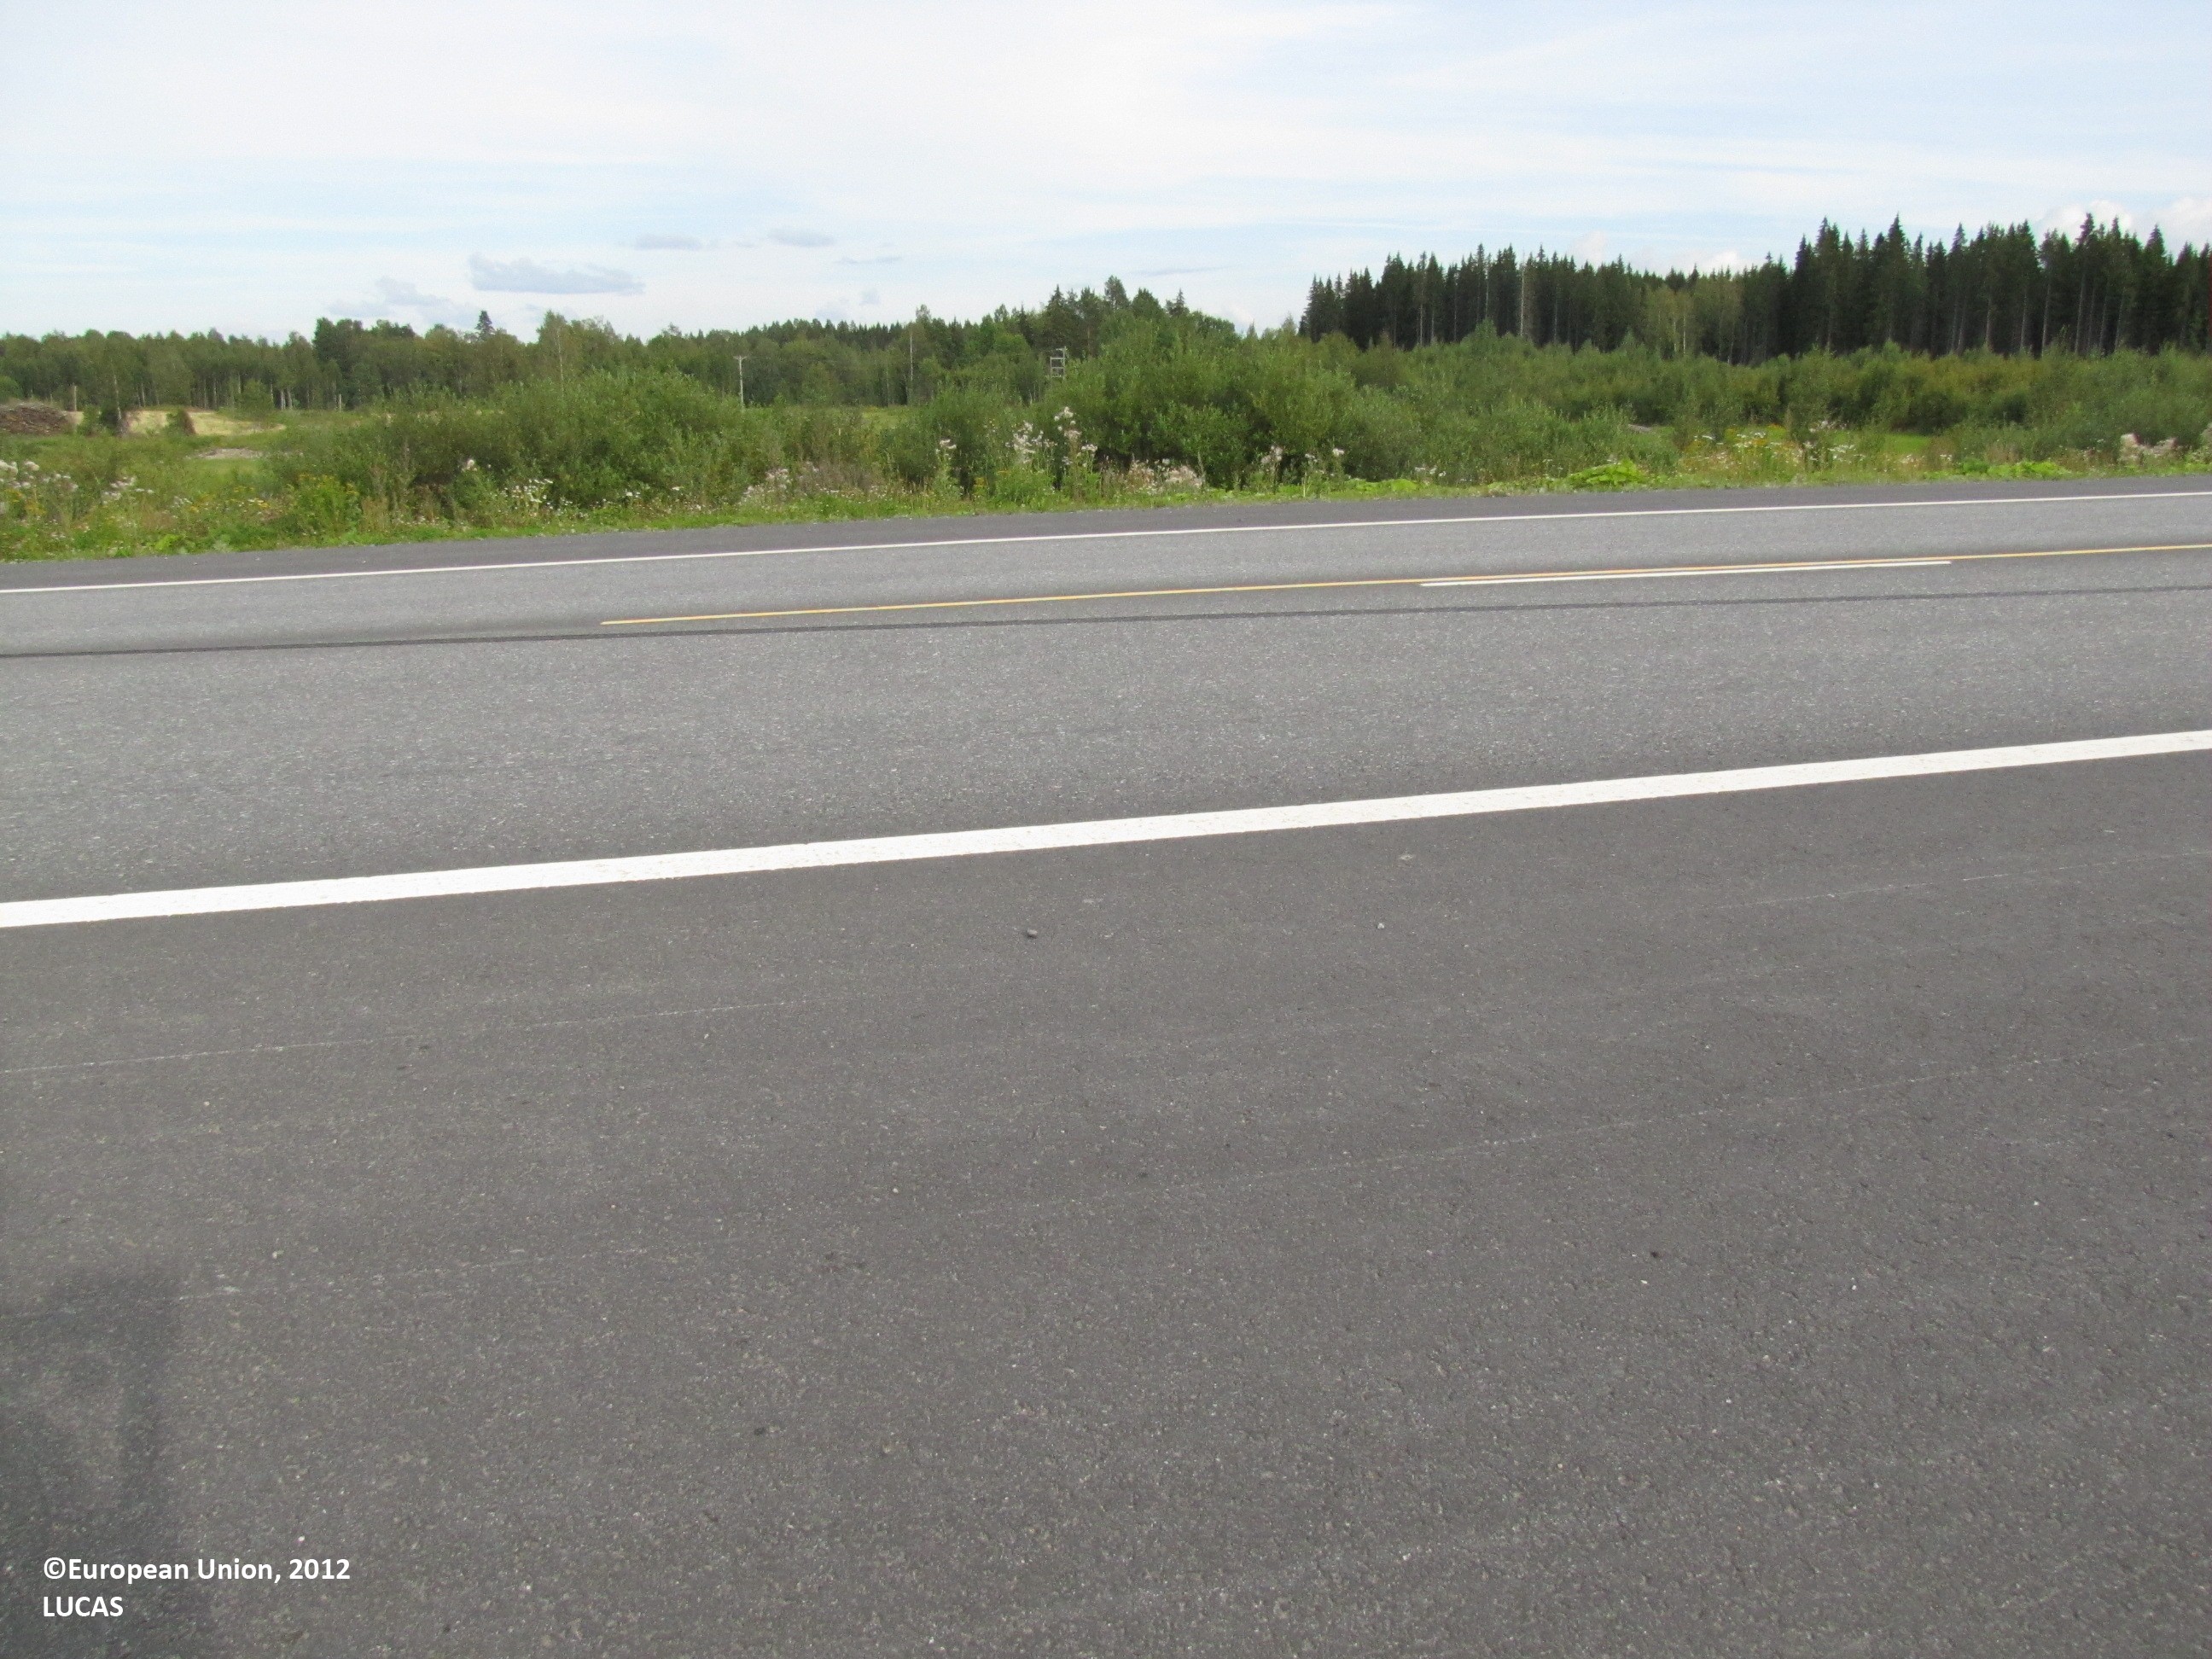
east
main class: Grassland
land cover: Grassland without tree/shrub cover
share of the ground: > 75 %
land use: Air transport
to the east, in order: Grassland without tree/shrub cover; Ditches and canals; Broadleaved woodland; Ditches and canals; Tracks; Grassland without tree/shrub cover; Broadleaved woodland; Grassland with sparse tree/shrub cover; Fences; Grassland with sparse tree/shrub cover; Rocks and stones; Paved roads, cycling and walking lanes; Spontaneously vegetated surfaces; Ditches and canals; Shrubland without tree cover
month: August
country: FI
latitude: 61.4201
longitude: 23.6304
